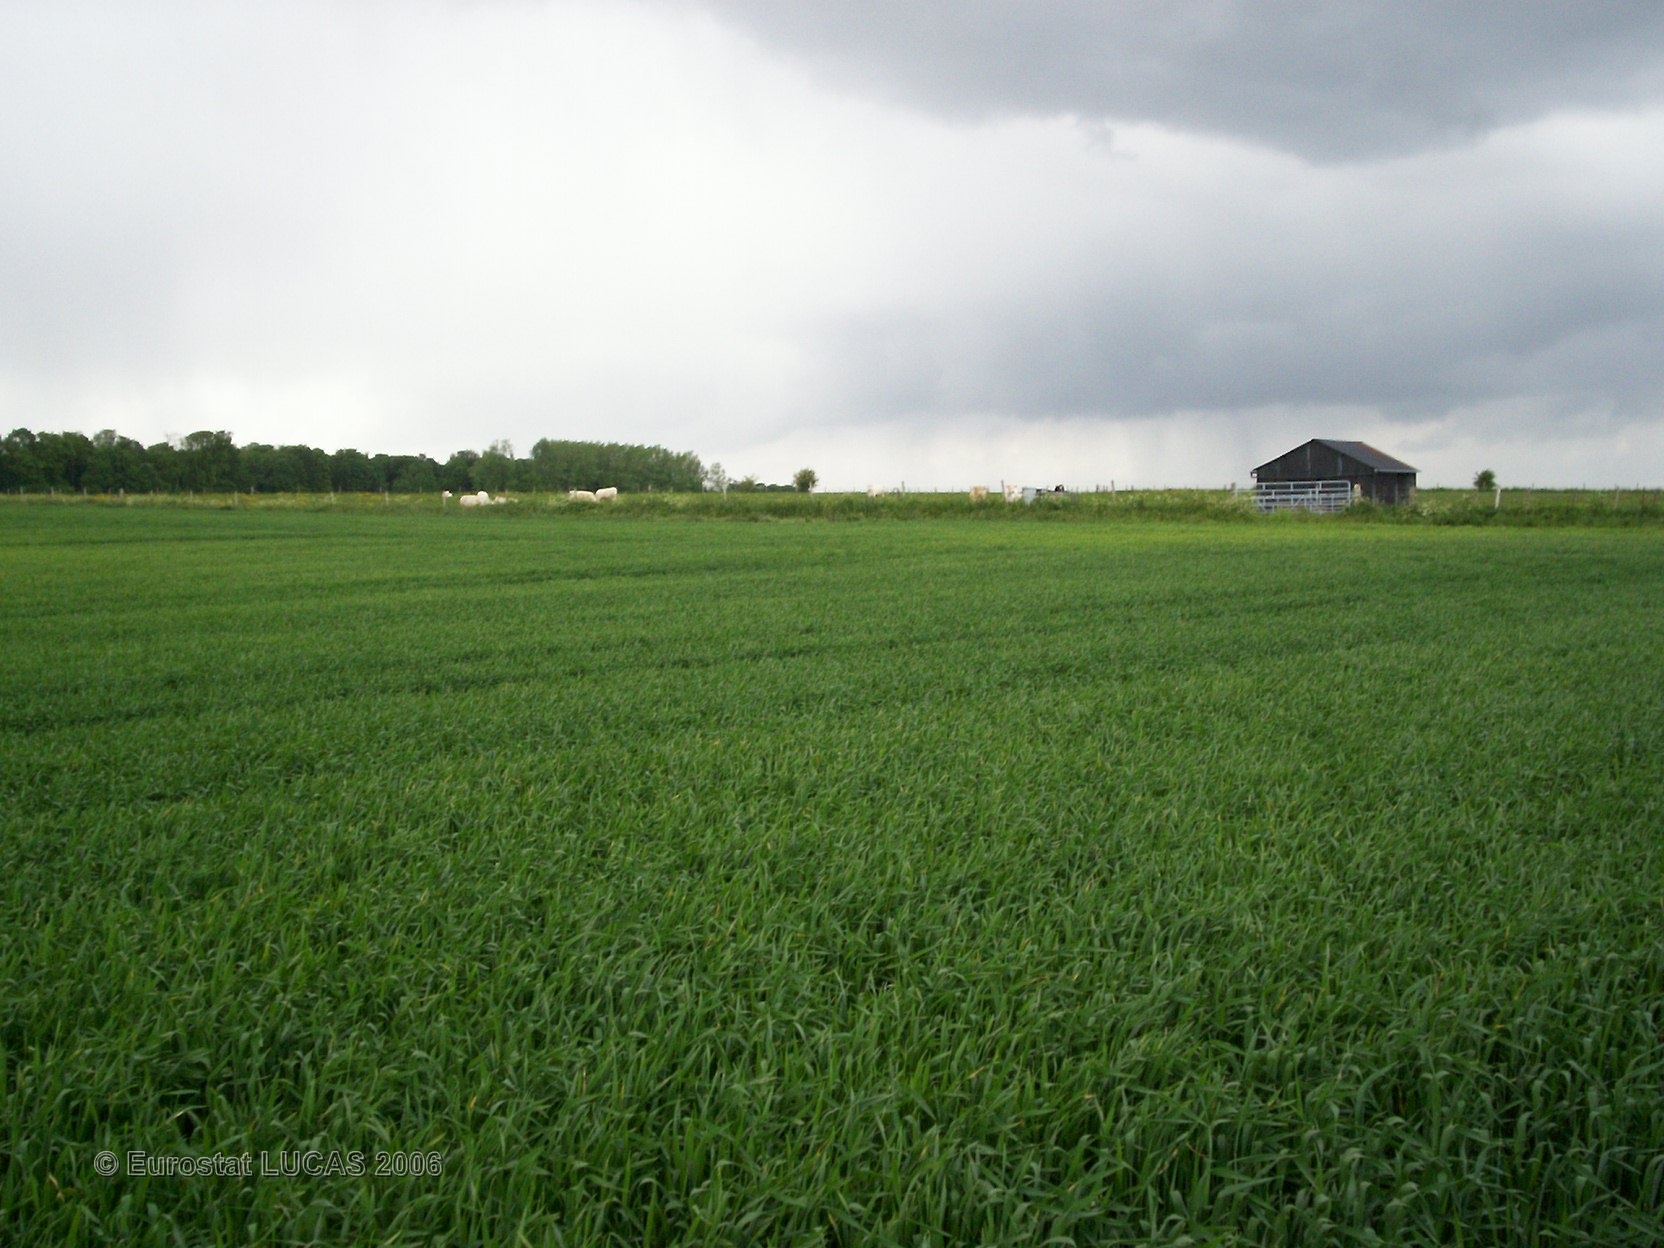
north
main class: Grassland
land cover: Grassland without tree/shrub cover
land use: Agriculture (excluding fallow land and kitchen gardens)
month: May
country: FR
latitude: 50.2110
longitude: 2.5470
